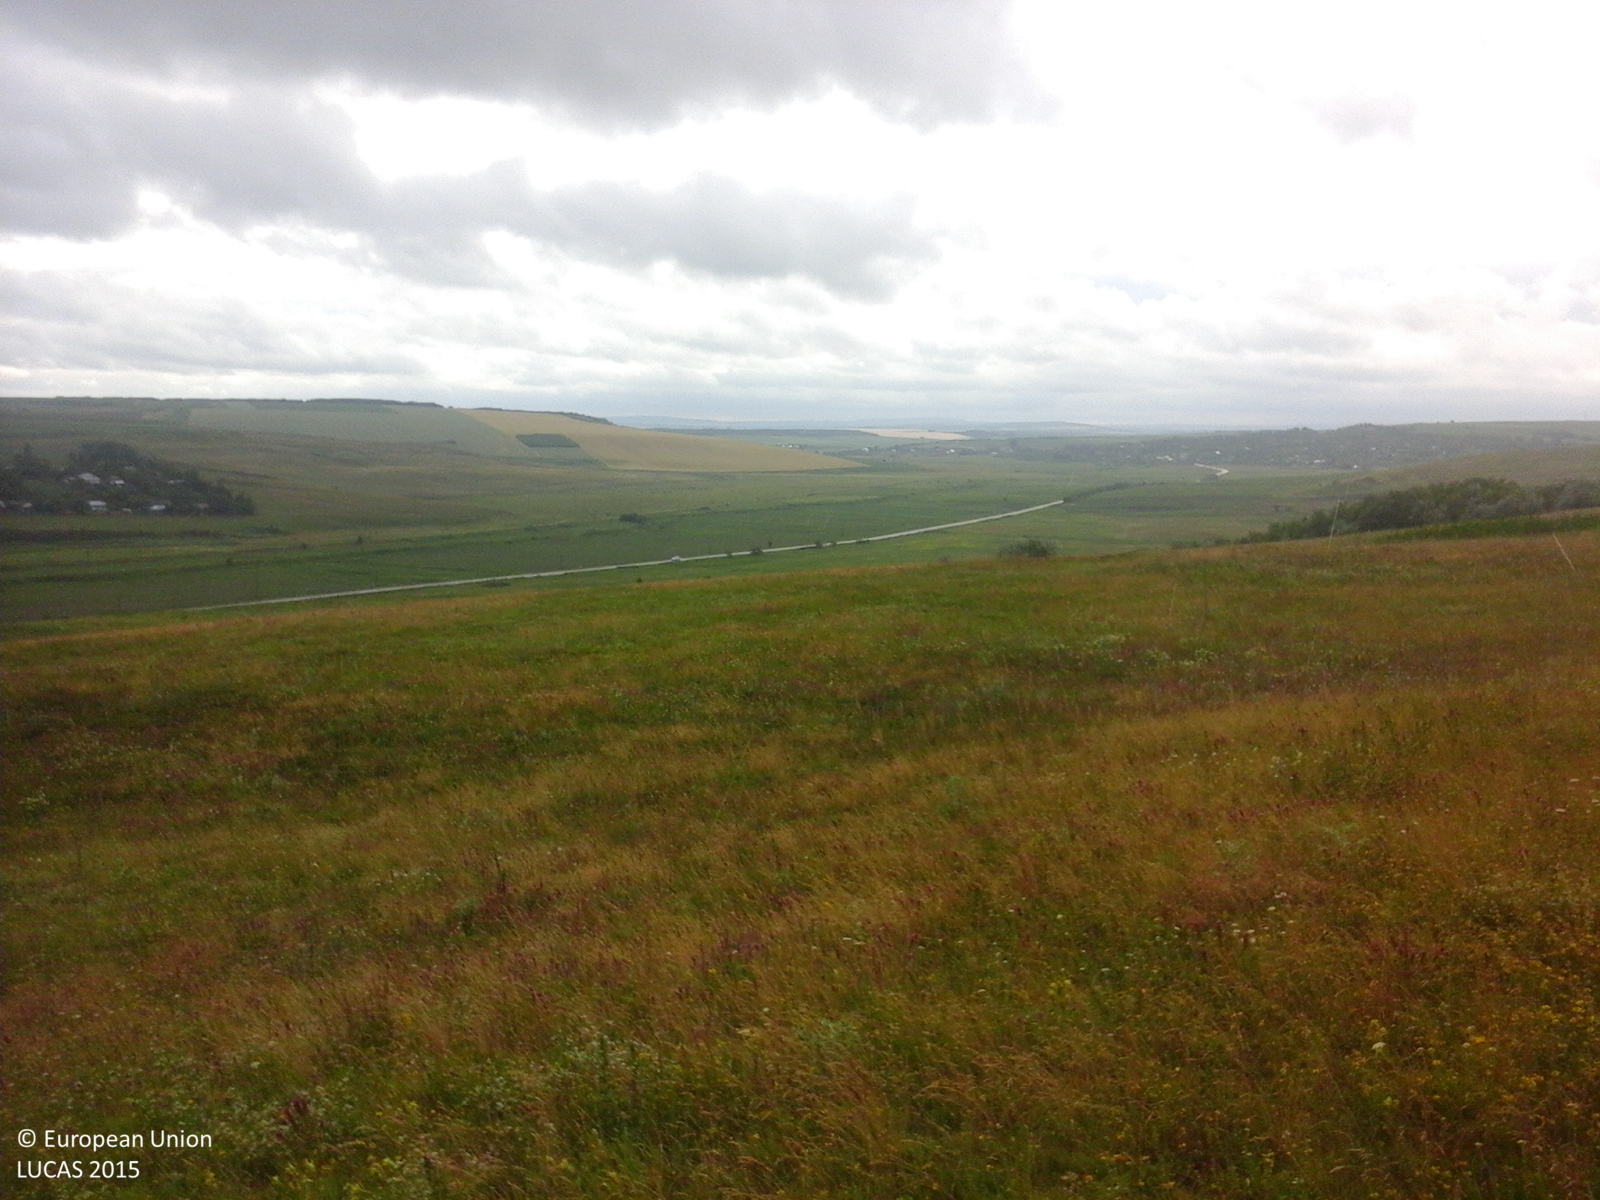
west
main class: Grassland
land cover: Grassland with sparse tree/shrub cover
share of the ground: > 75 %
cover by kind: herbaceous plants 90 %, broadleaved forest trees 5 %, shrubs 5 %
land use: Agriculture (excluding fallow land and kitchen gardens)
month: June
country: RO
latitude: 47.9273
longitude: 26.5966
